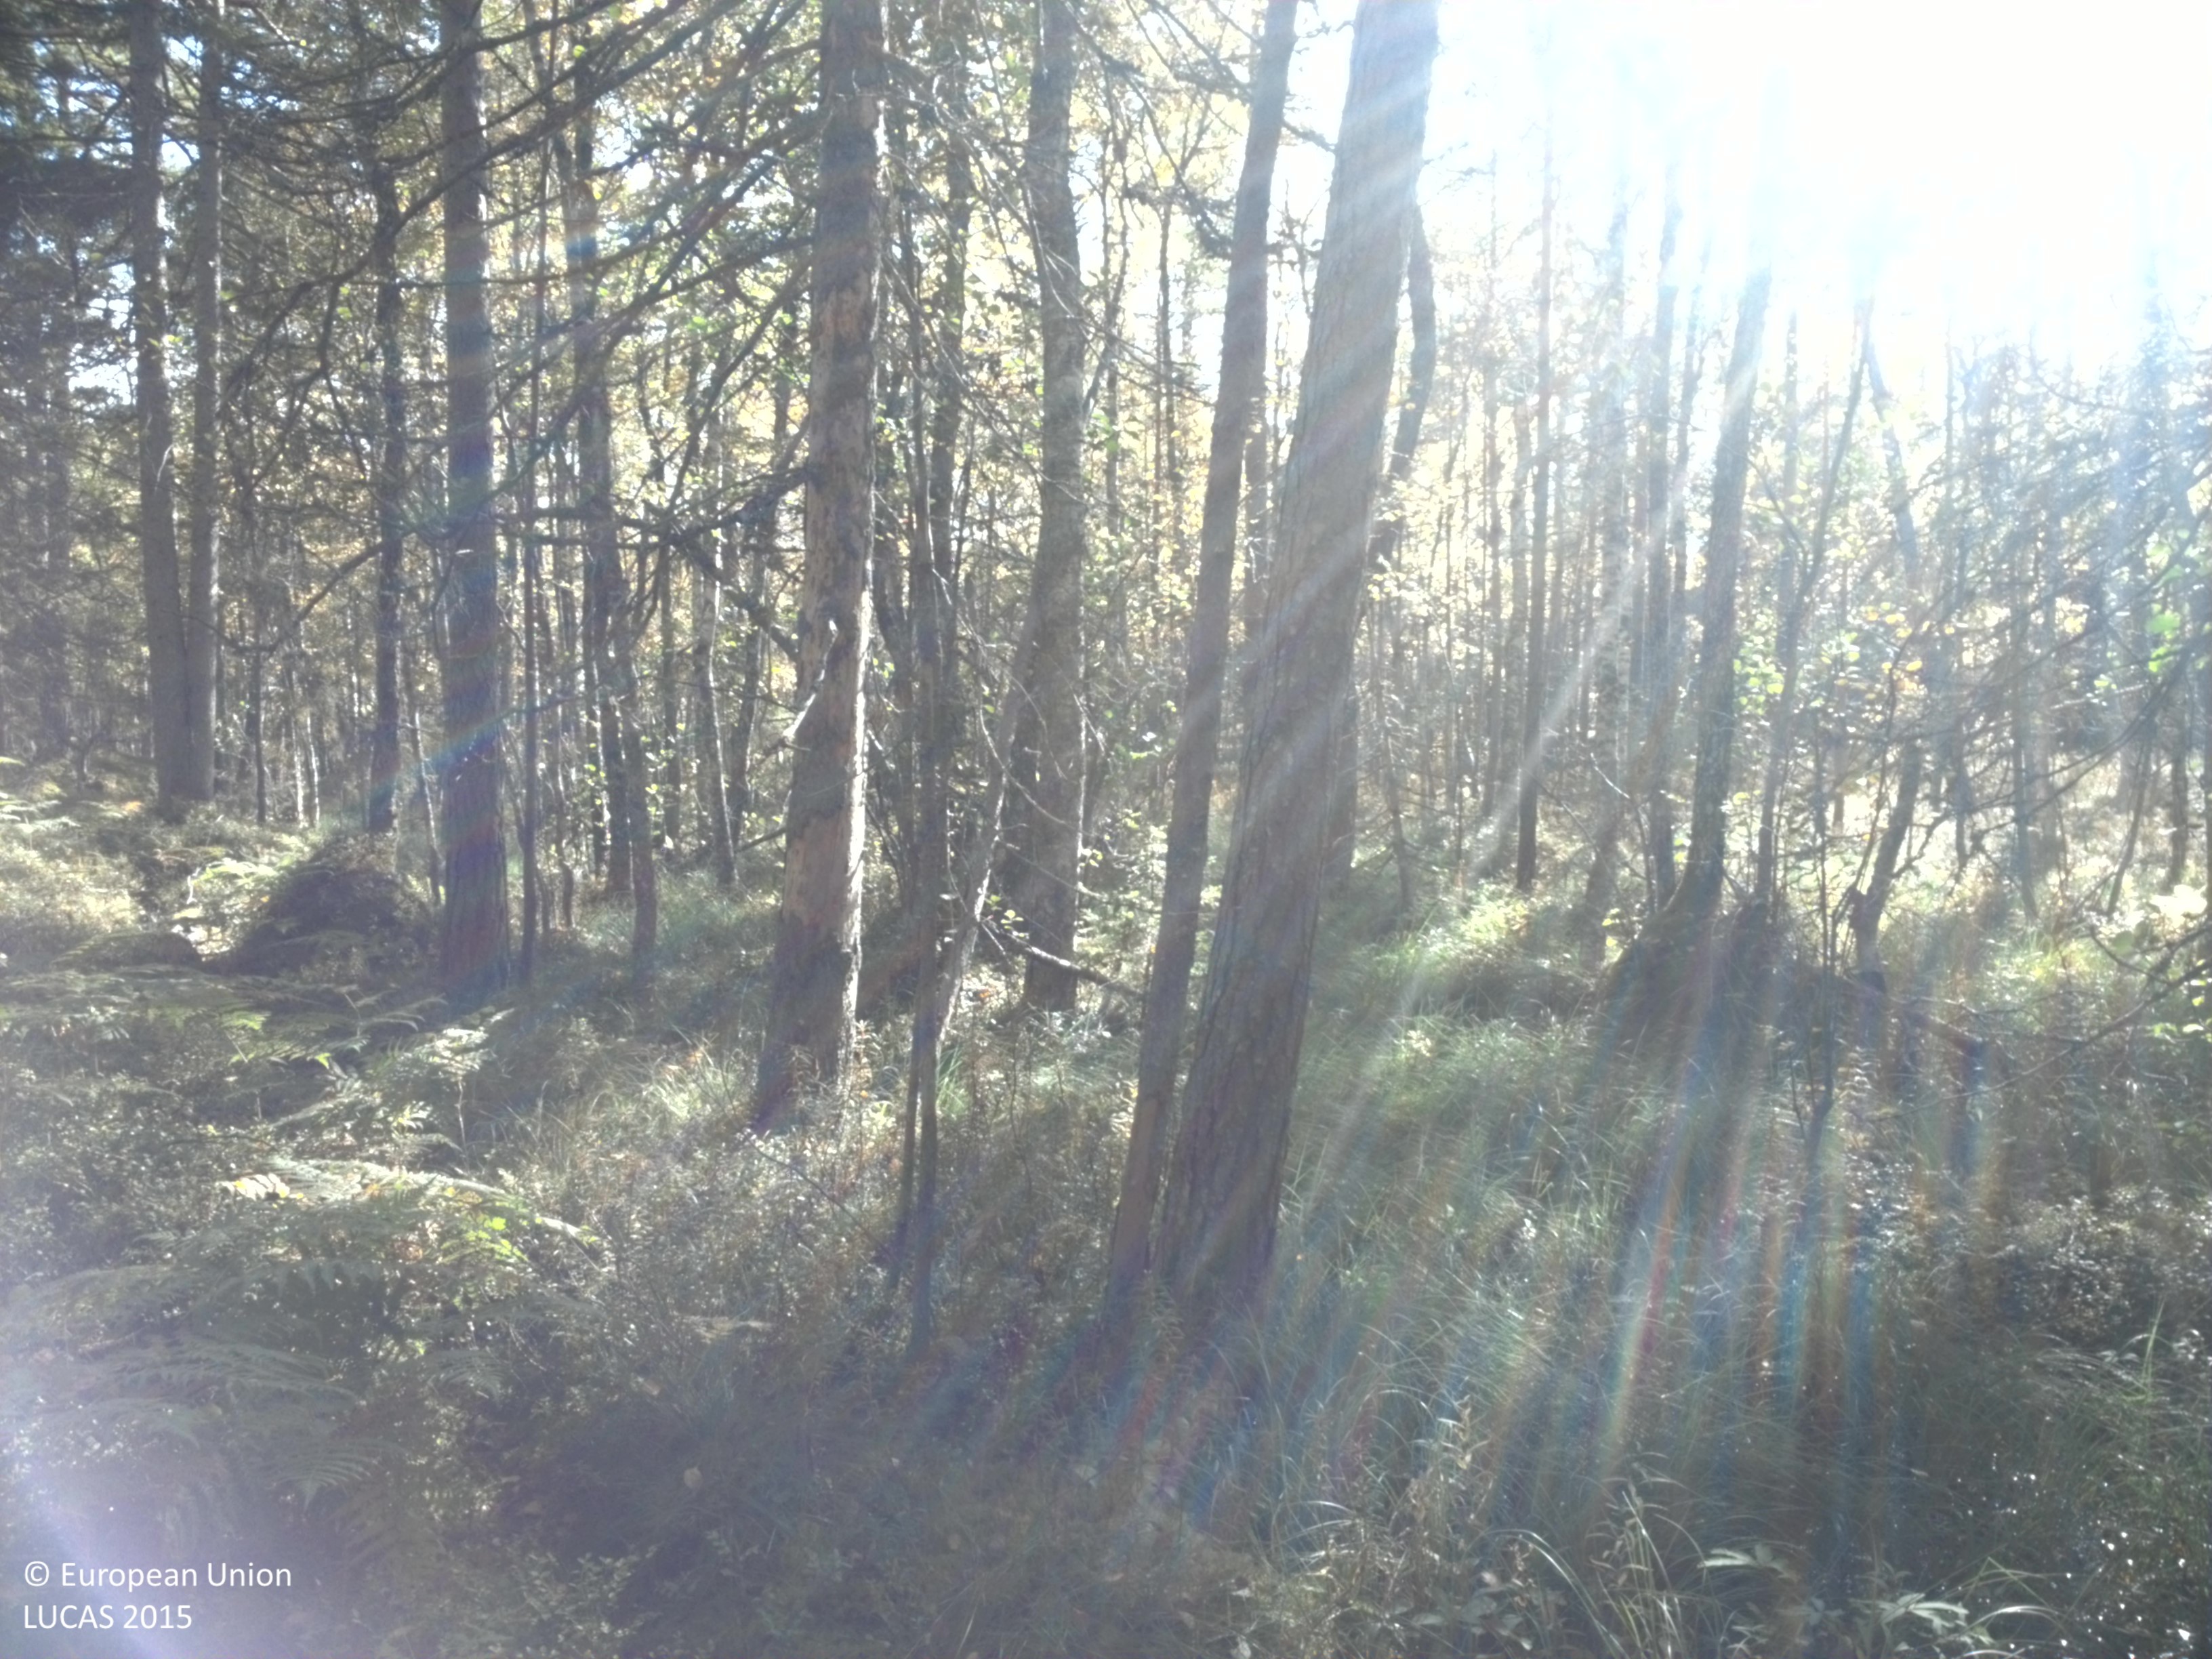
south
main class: Woodland
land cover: Pine dominated mixed woodland
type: boreal forest
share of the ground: 50 - 75 %
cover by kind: coniferous forest trees 45 %, broadleaved forest trees 25 %, shrubs 20 %, lichens and mosses 10 %
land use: Forestry
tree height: > 5 m
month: September
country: SE
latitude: 59.7930
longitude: 18.8568
